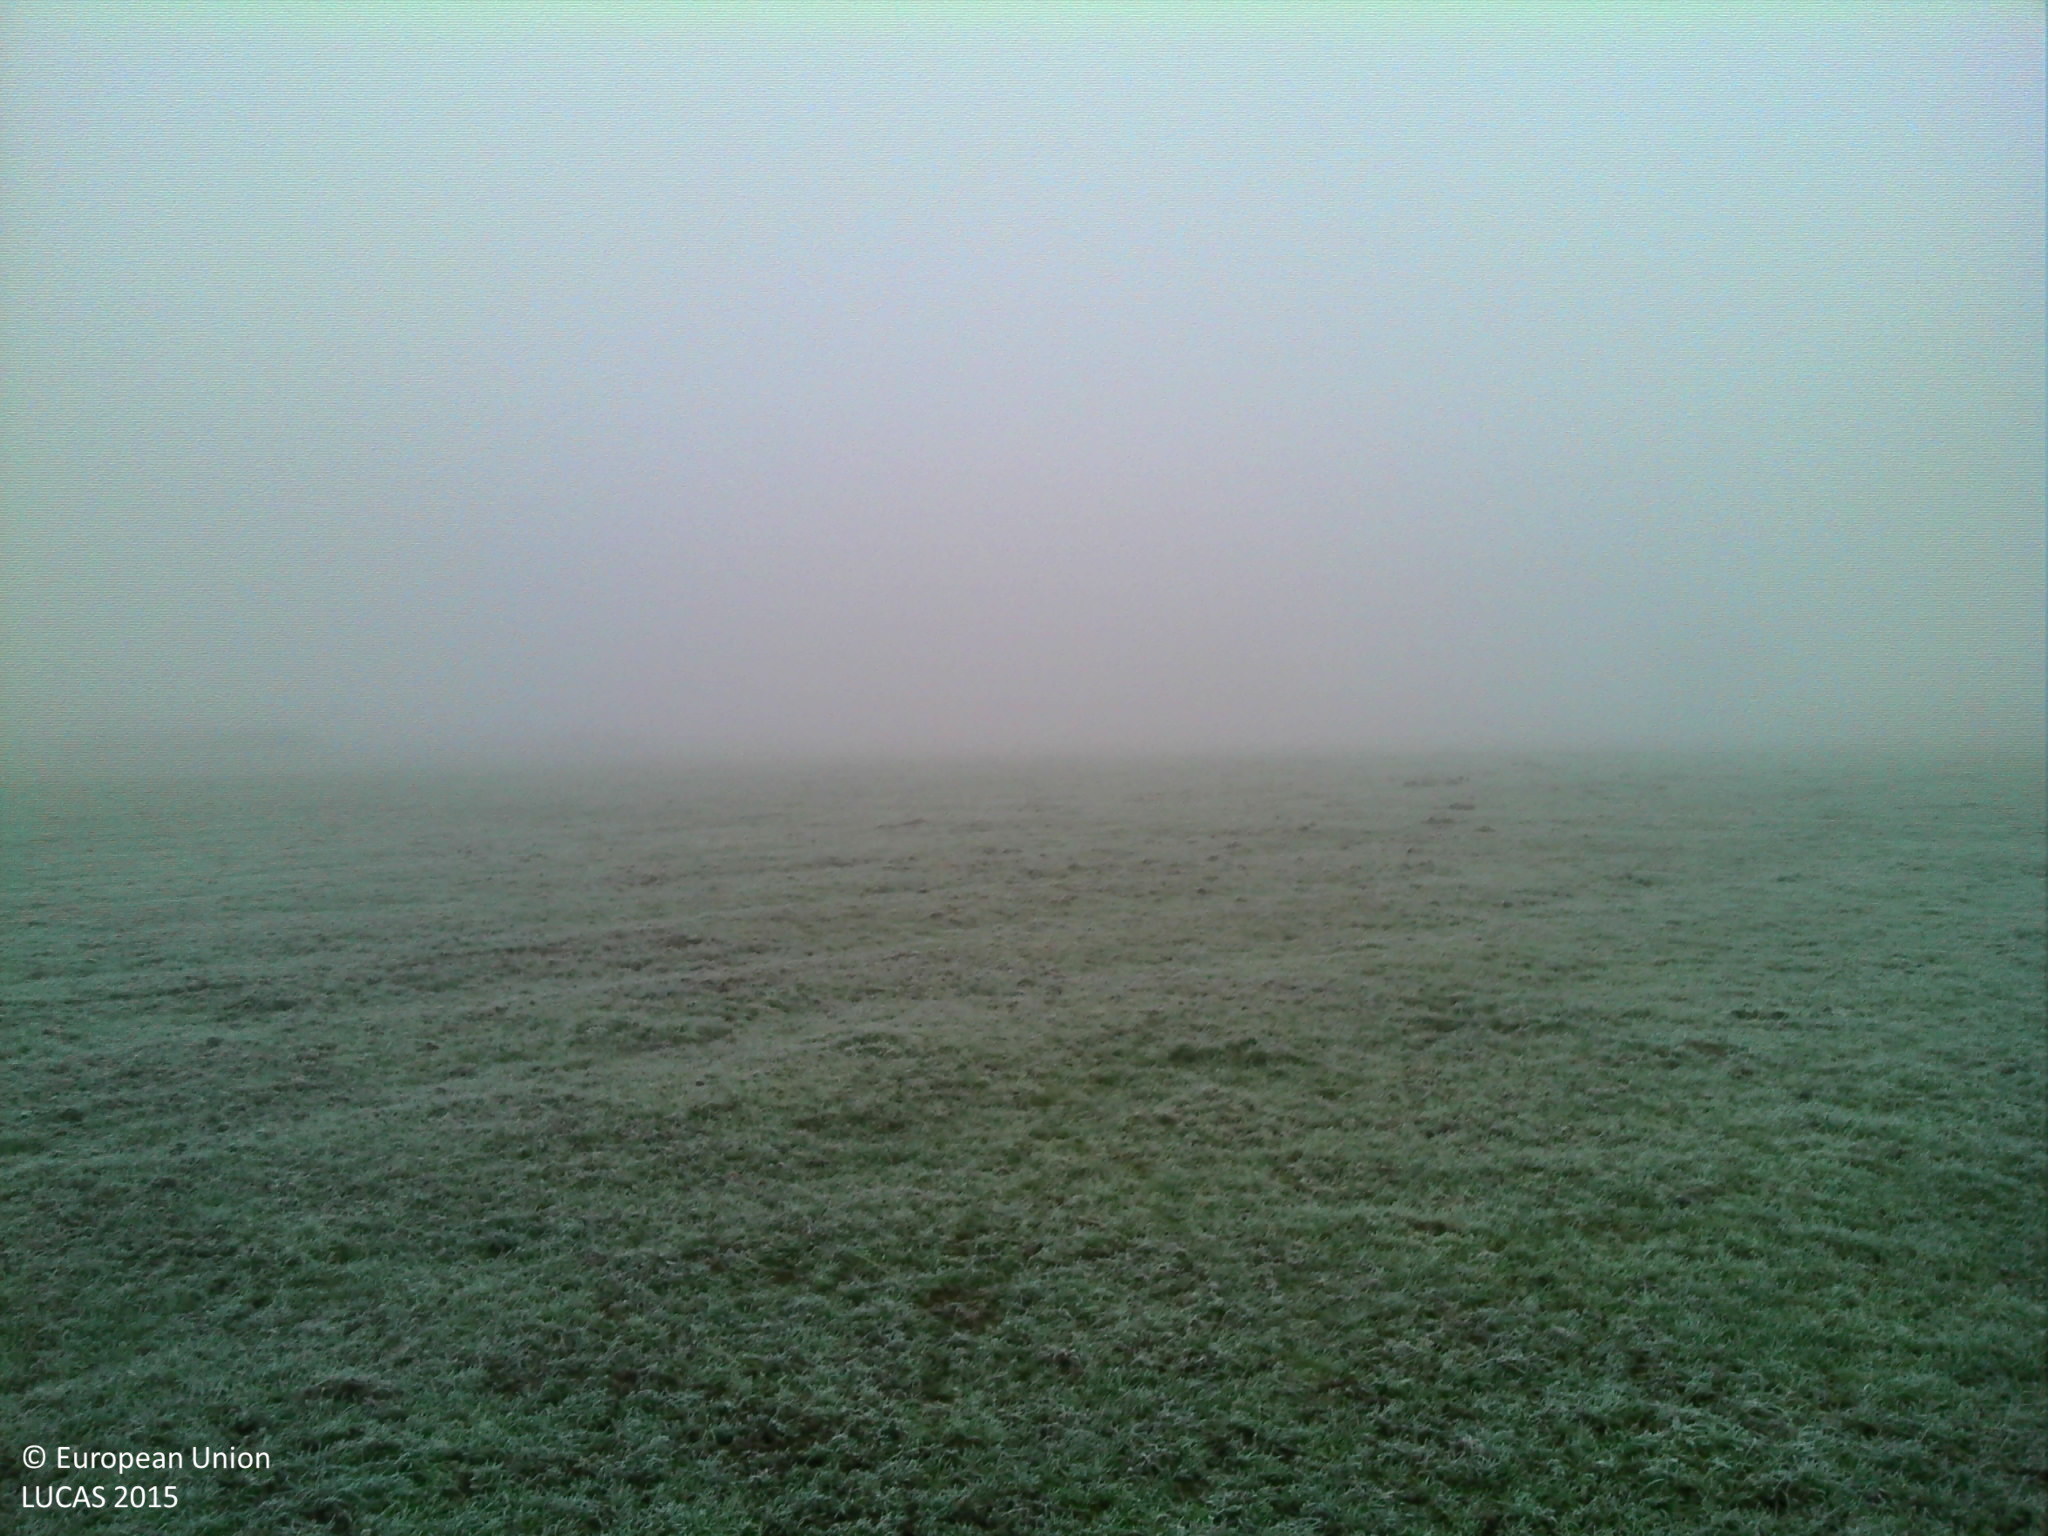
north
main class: Grassland
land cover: Grassland without tree/shrub cover
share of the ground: > 75 %
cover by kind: herbaceous plants 100 %
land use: Agriculture (excluding fallow land and kitchen gardens)
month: November
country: FR
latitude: 46.5925
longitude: 3.5902
